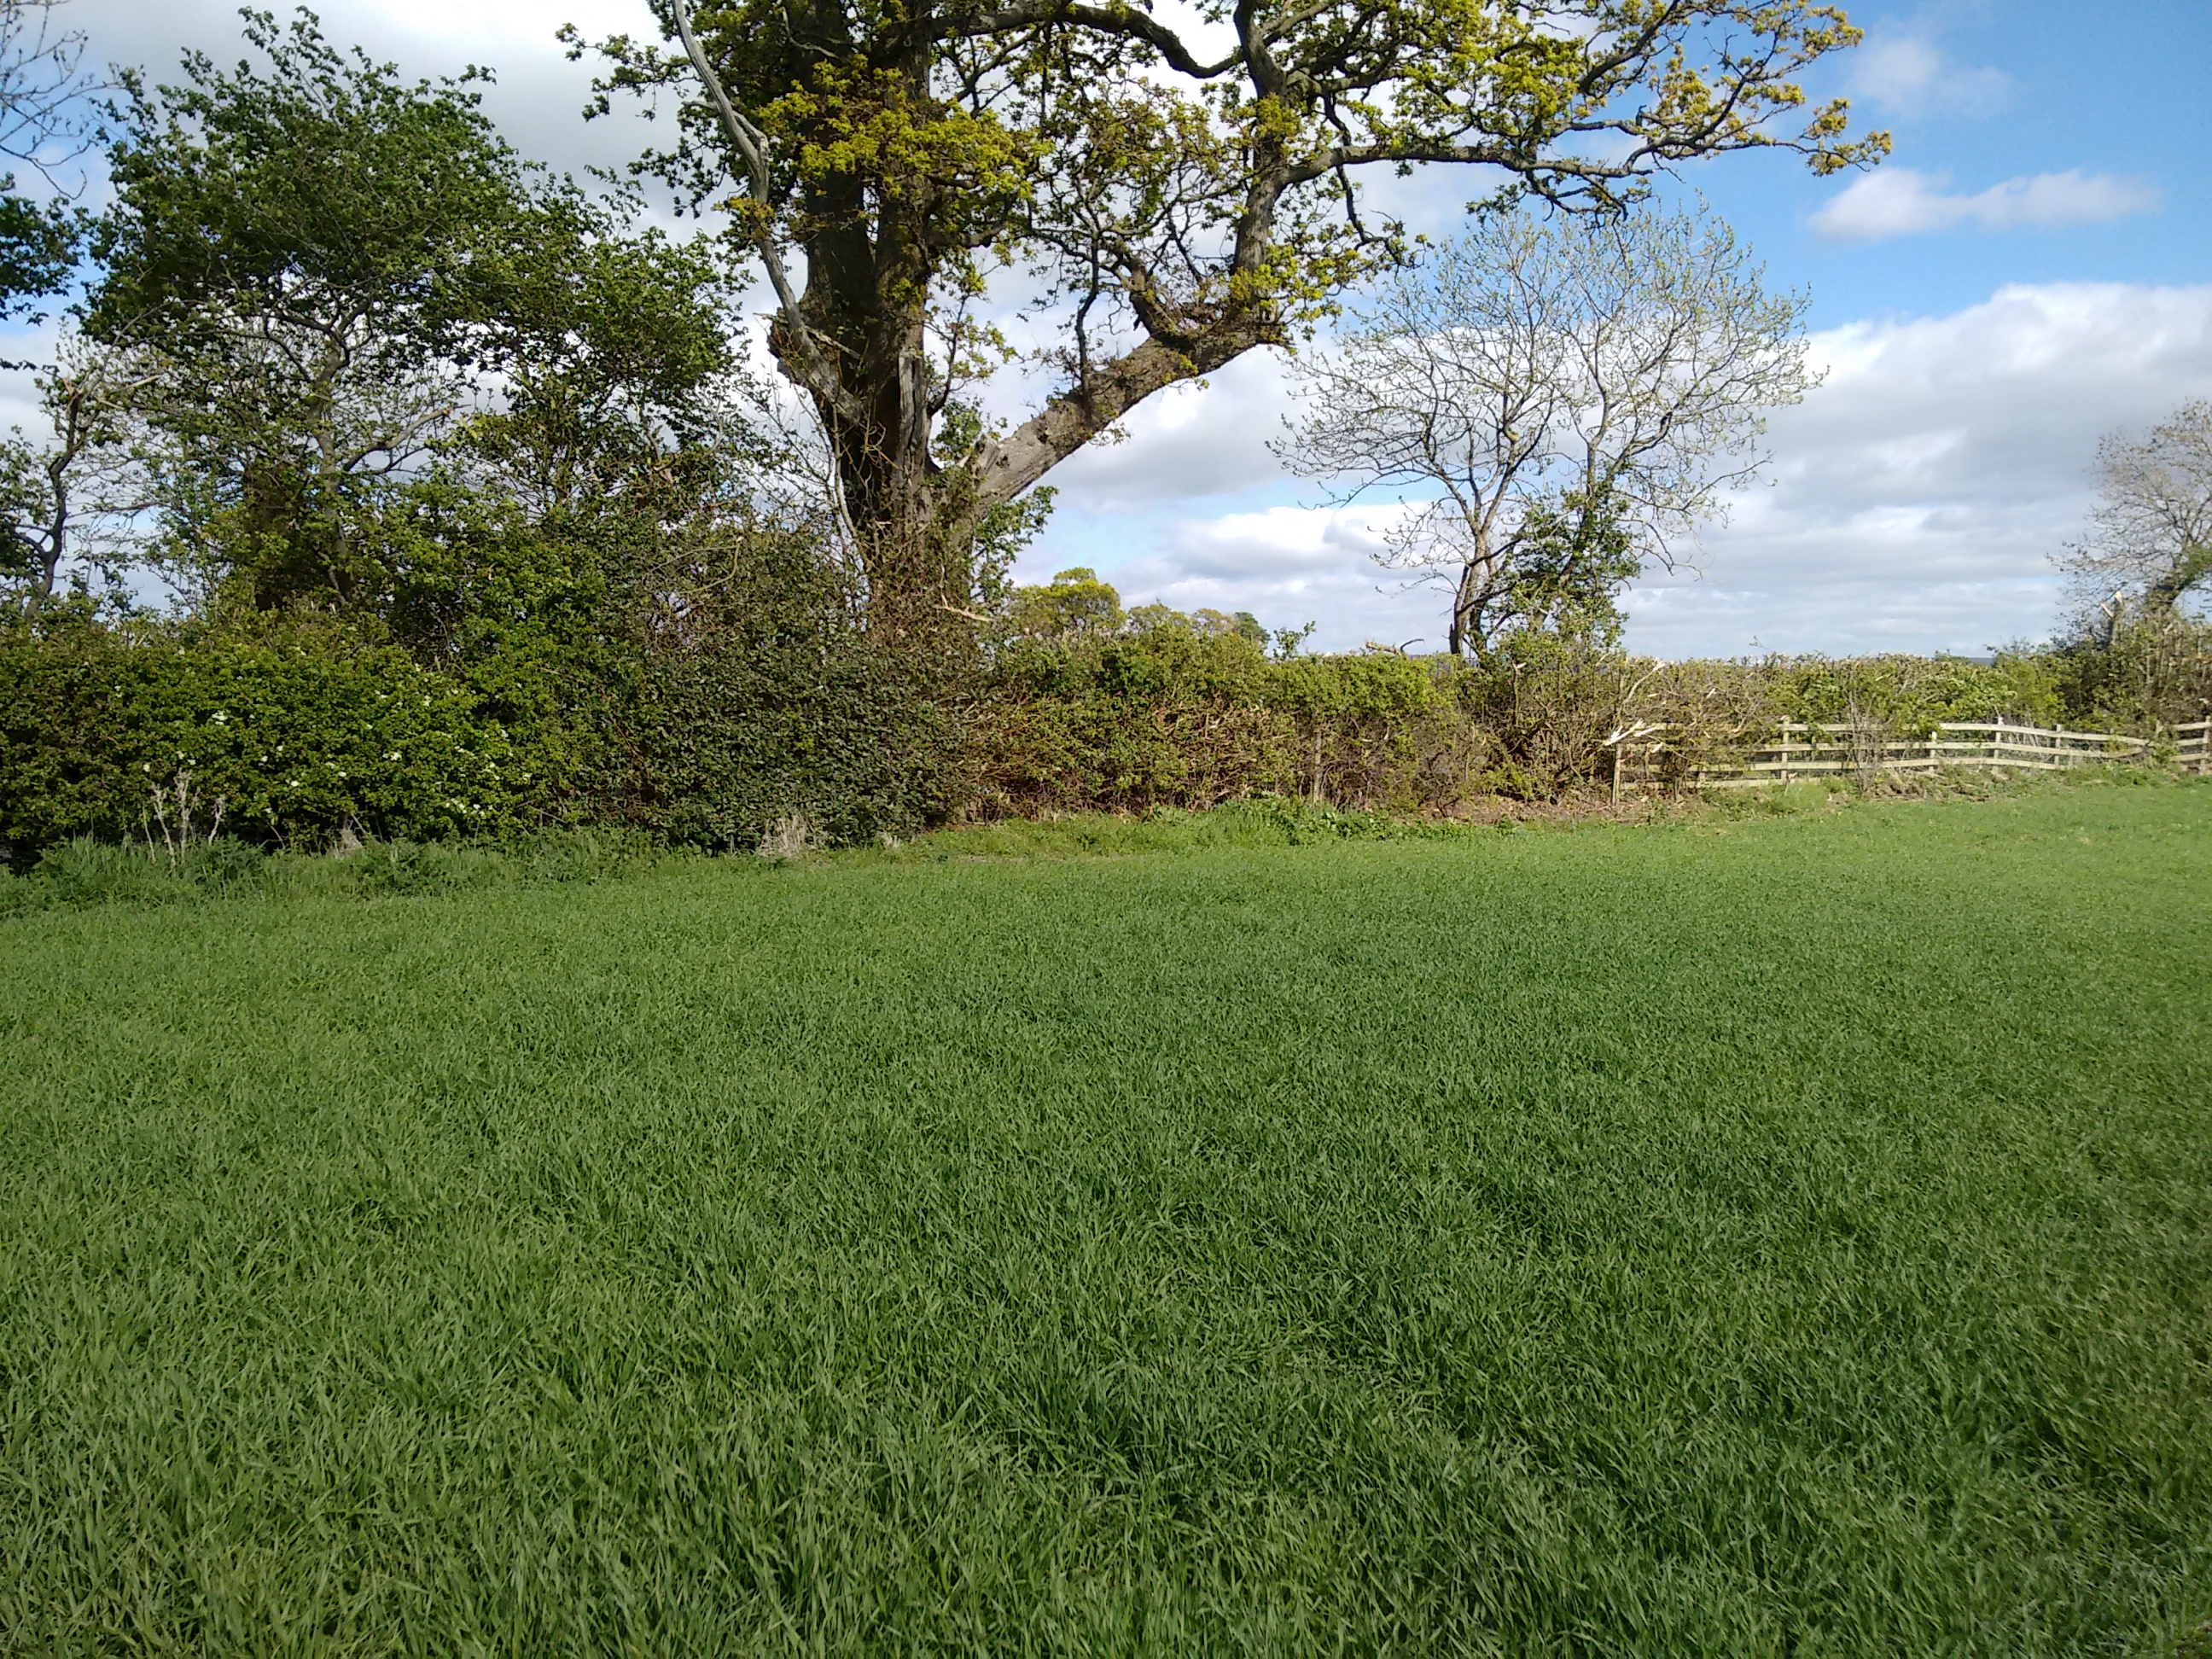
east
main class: Cropland
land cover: Barley
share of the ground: > 75 %
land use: Agriculture (excluding fallow land and kitchen gardens)
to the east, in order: Barley; Fences; Abandoned hedges; Single bushes/trees; Fences; Grass margins; Paved roads, cycling and walking lanes; Grass margins; Managed hedges; Fences; Grass margins; Barley; Grass margins; Fences; Managed hedges; Fences; Grass margins; Other bare soil
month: May
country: GB
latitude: 55.8937
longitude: -2.9398
